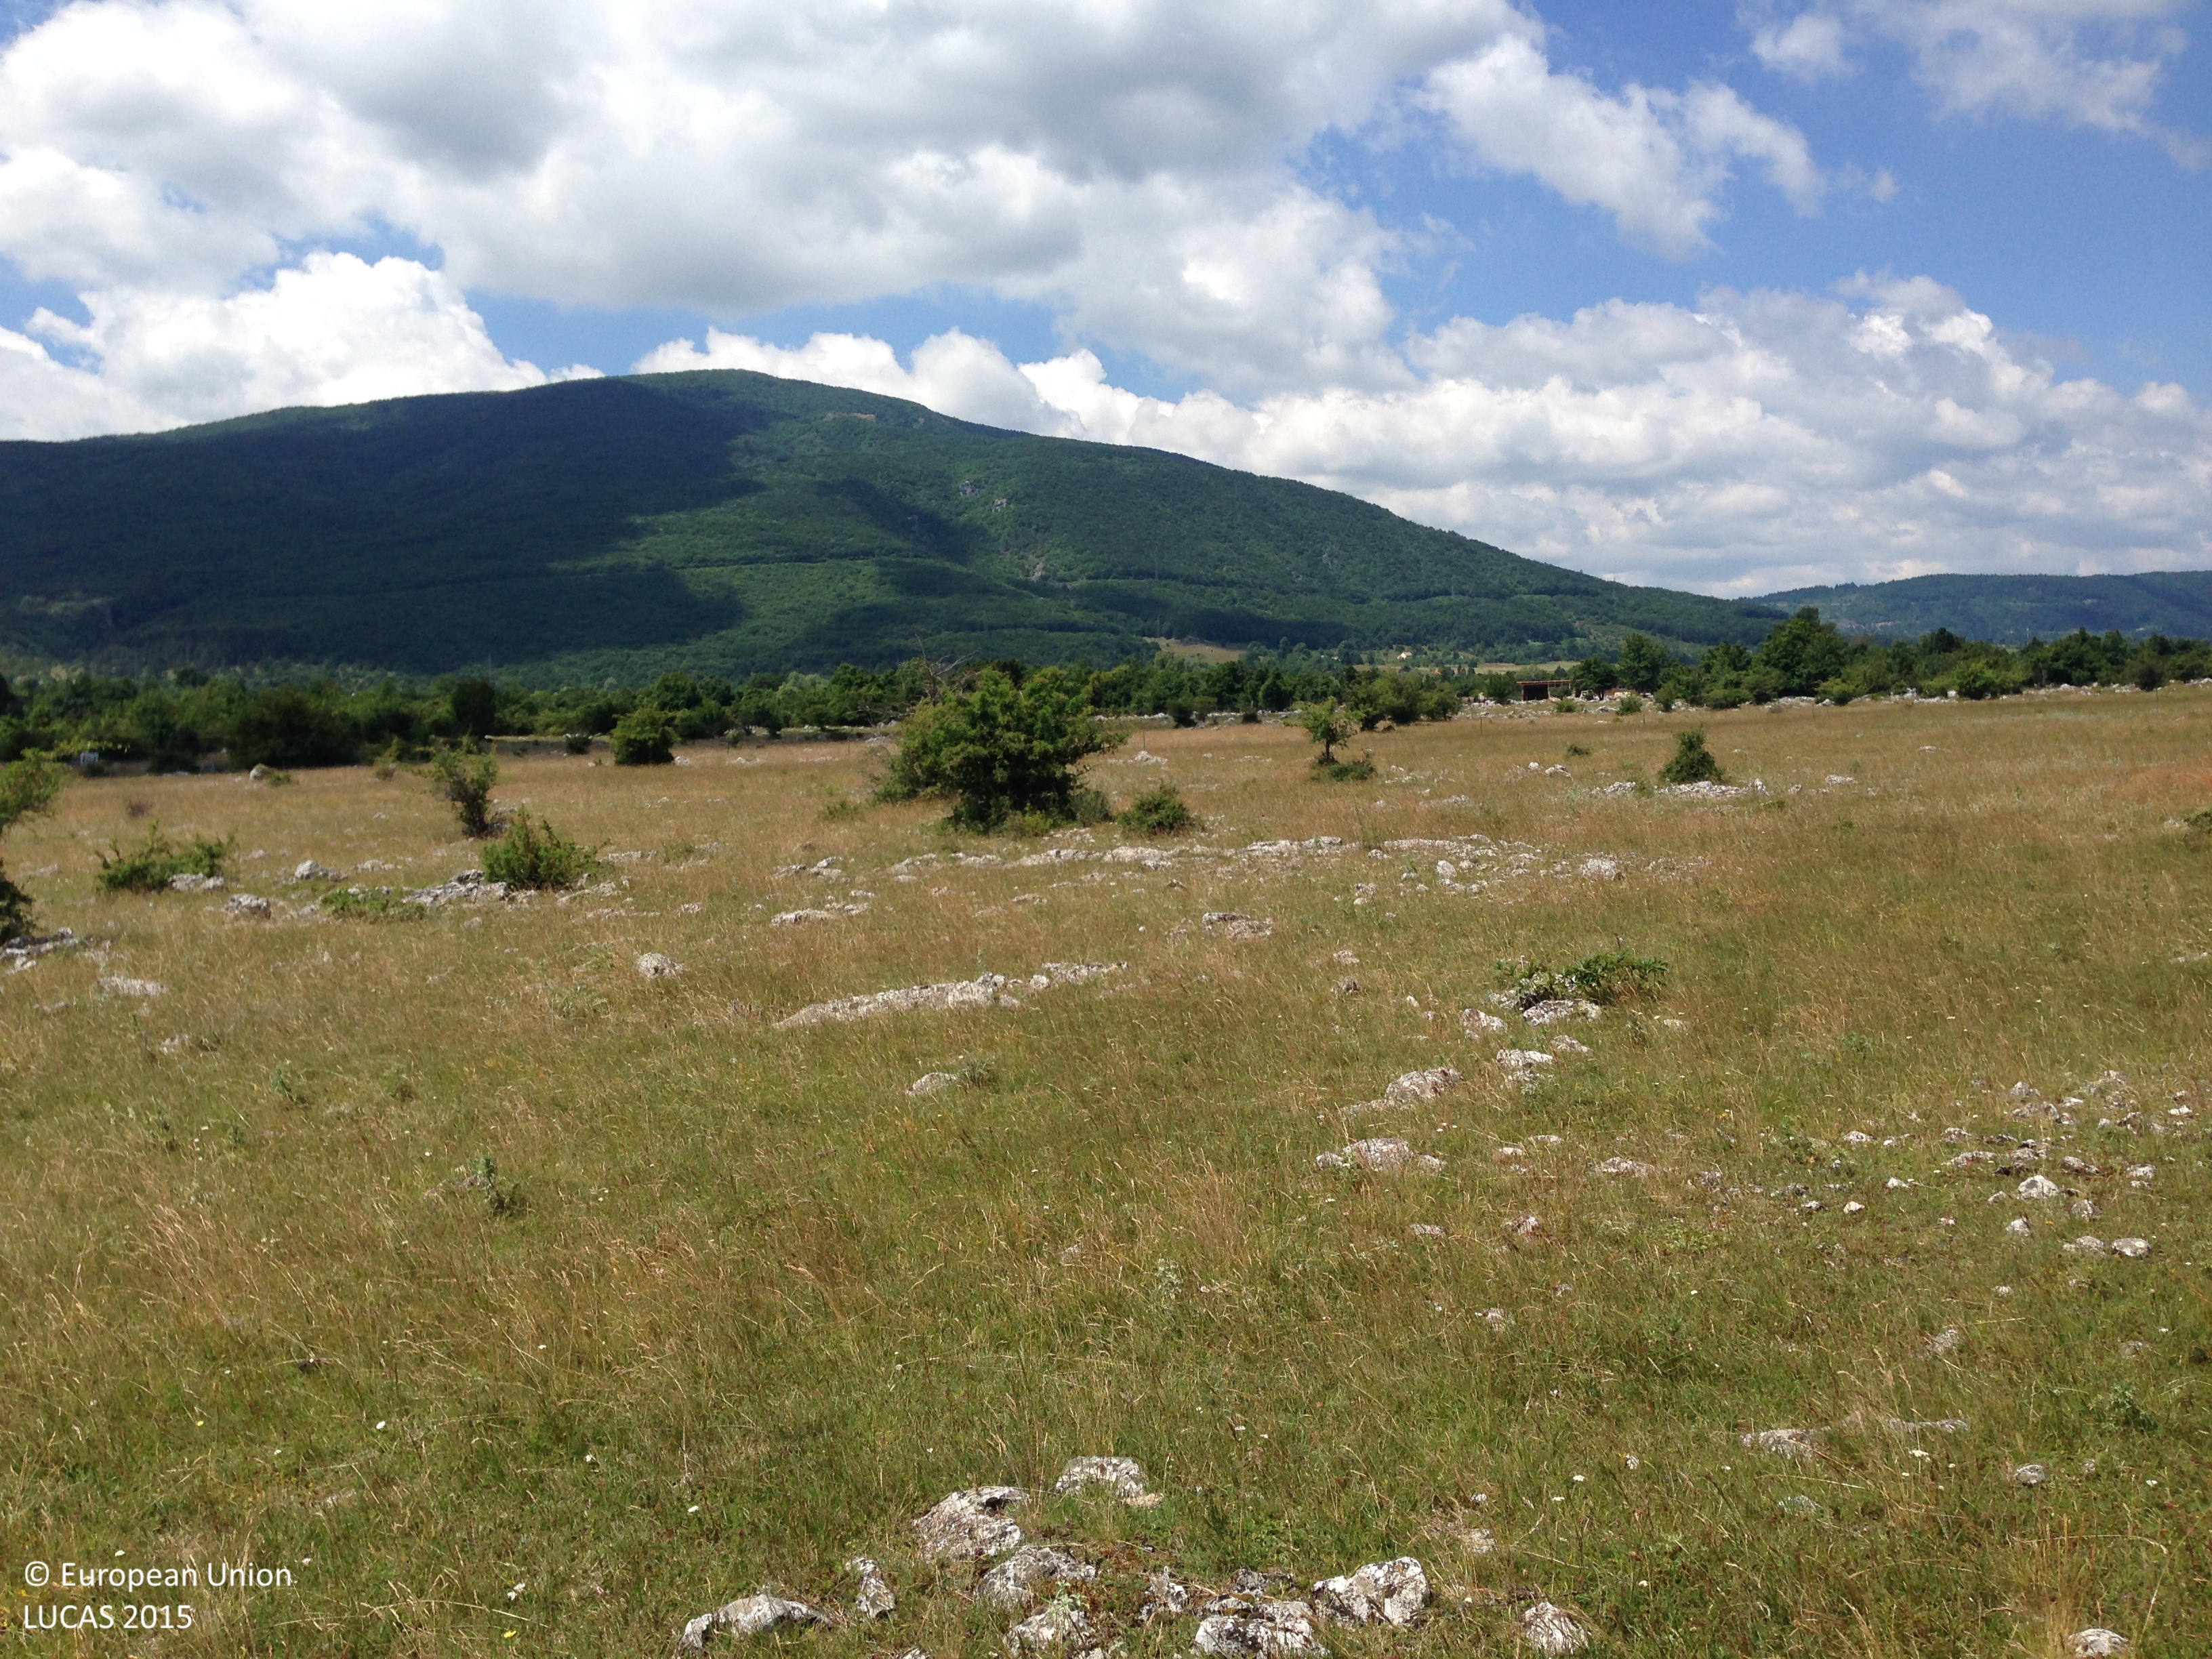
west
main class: Grassland
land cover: Grassland with sparse tree/shrub cover
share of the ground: > 75 %
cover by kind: herbaceous plants 65 %, unconsolidated bare surface 15 %, consolidated bare surface 10 %, broadleaved forest trees 5 %, shrubs 5 %
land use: Semi-natural and natural areas not in use
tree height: < 5 m
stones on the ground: < 10 %
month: June
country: HR
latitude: 44.7533
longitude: 15.7165
